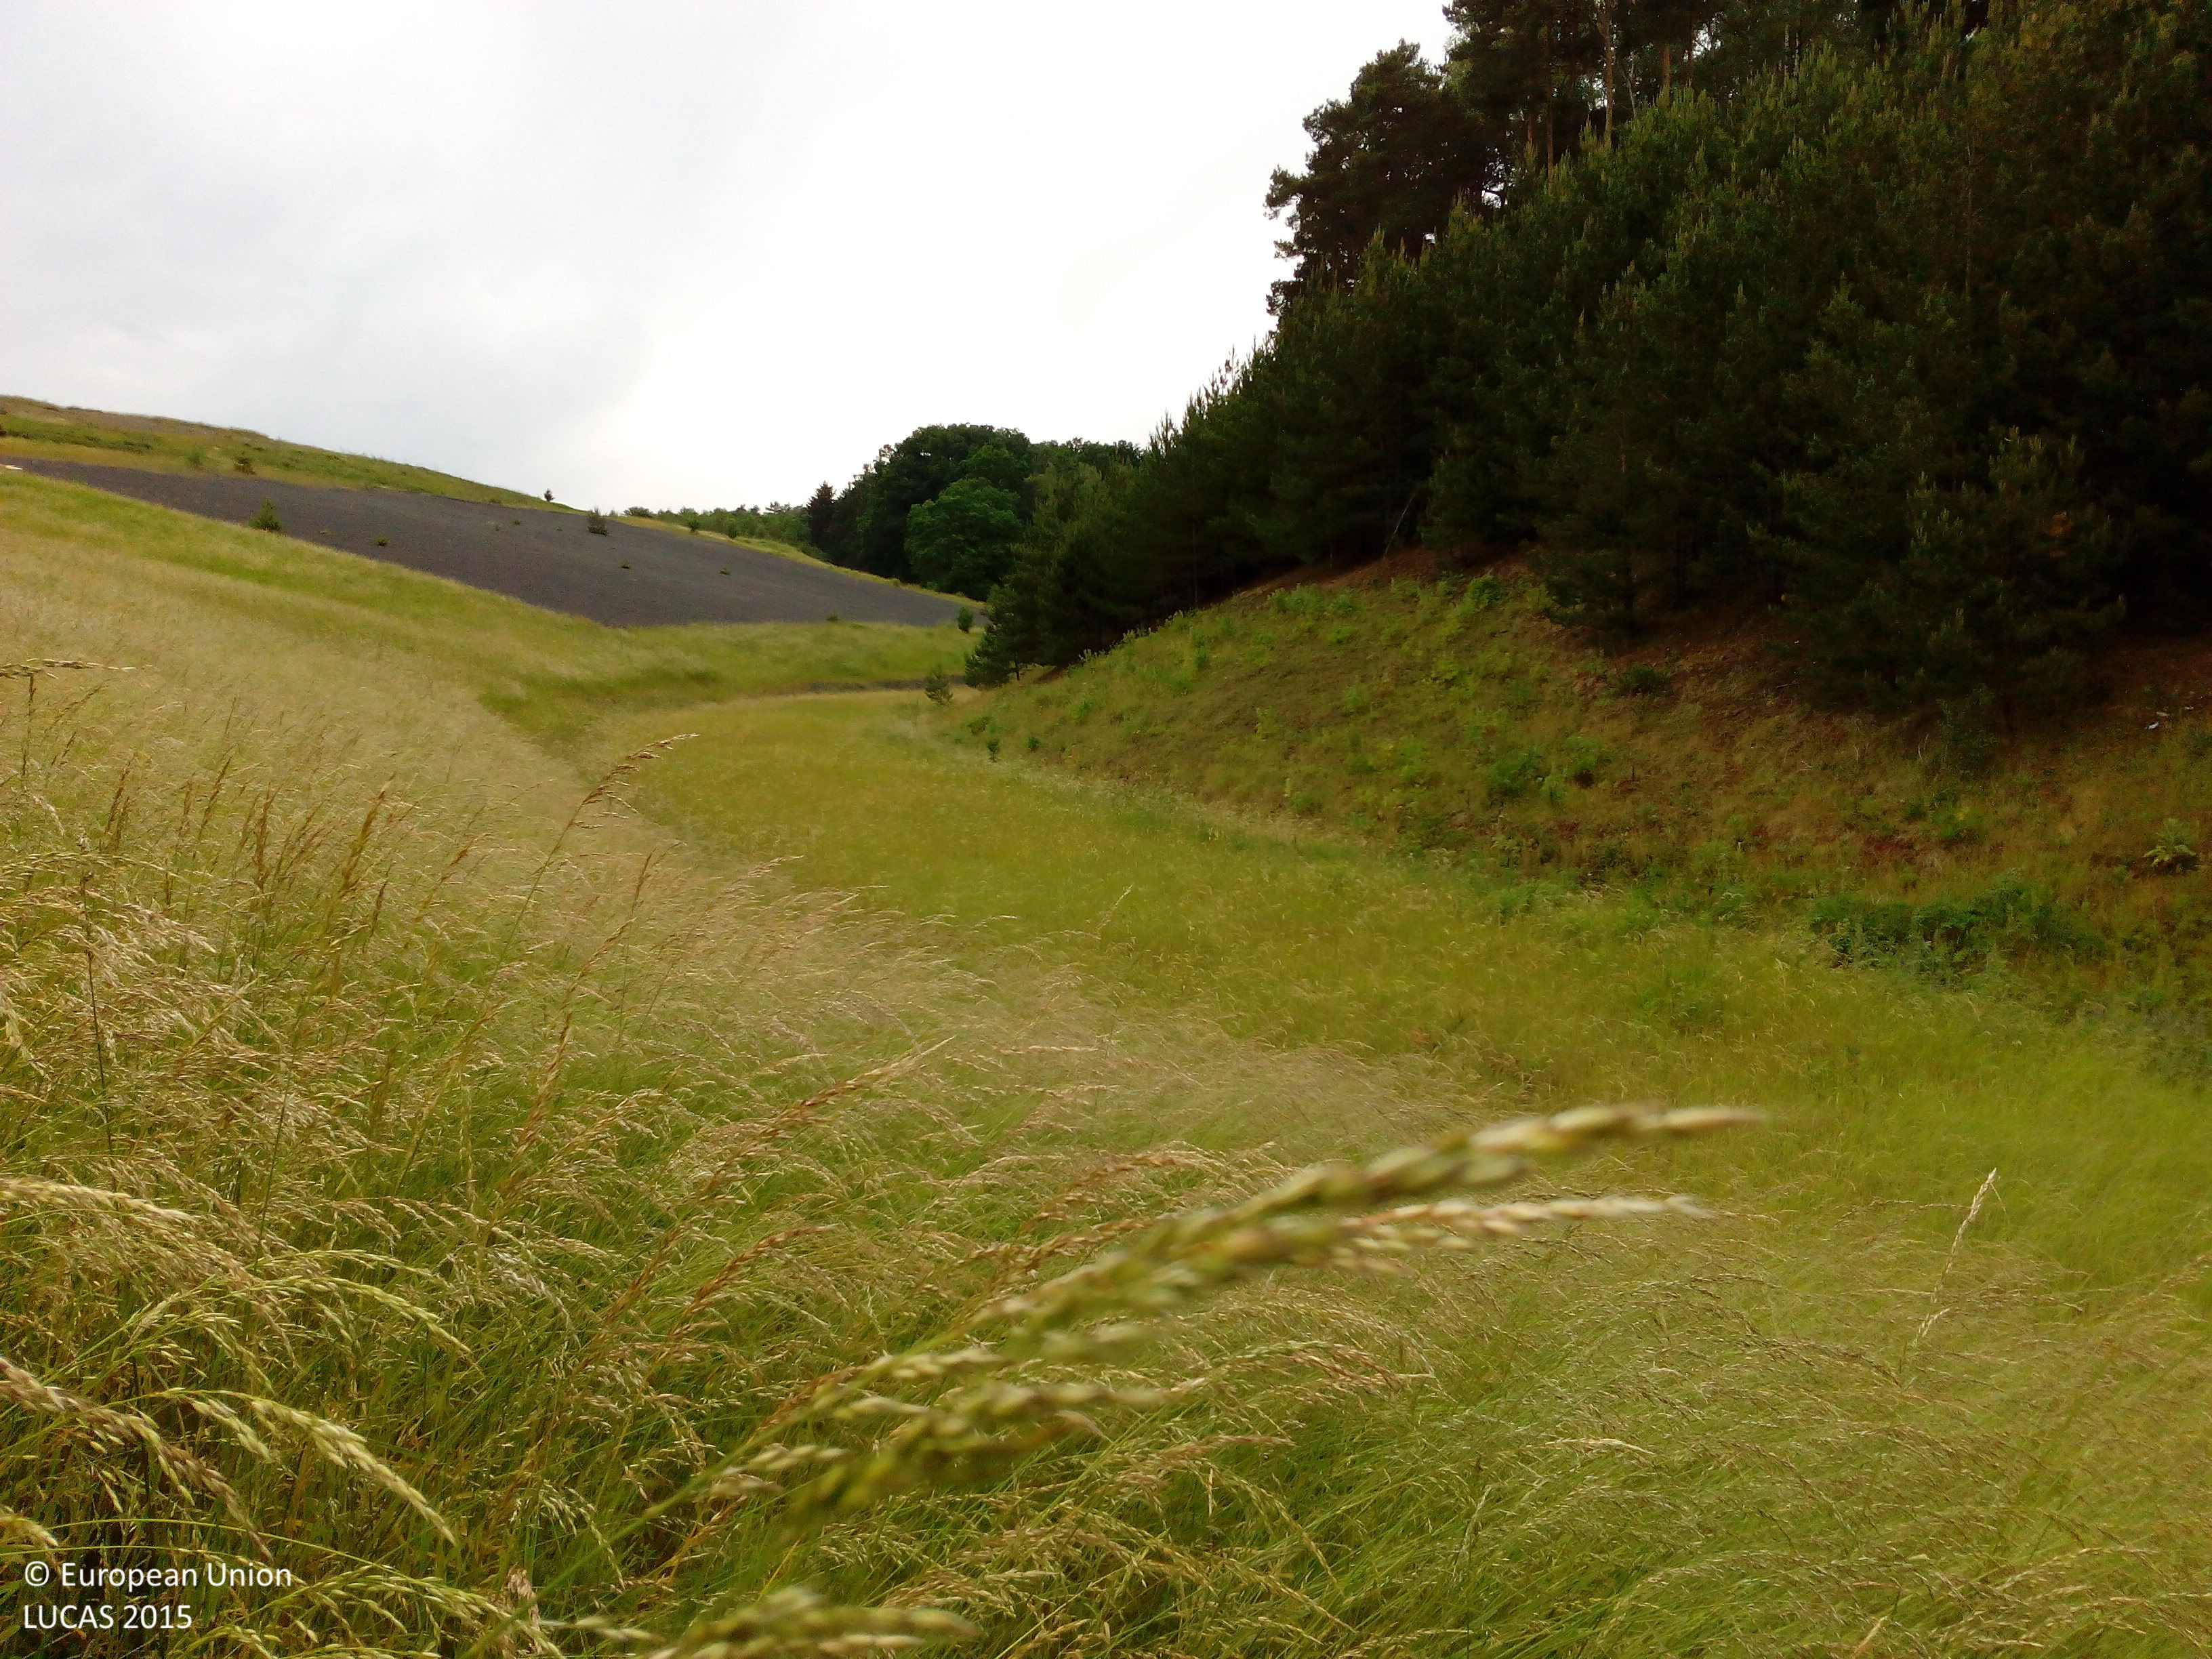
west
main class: Grassland
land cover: Grassland without tree/shrub cover
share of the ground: > 75 %
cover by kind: herbaceous plants 100 %
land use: Waste treatment
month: June
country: DE
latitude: 50.7125
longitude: 11.6000
